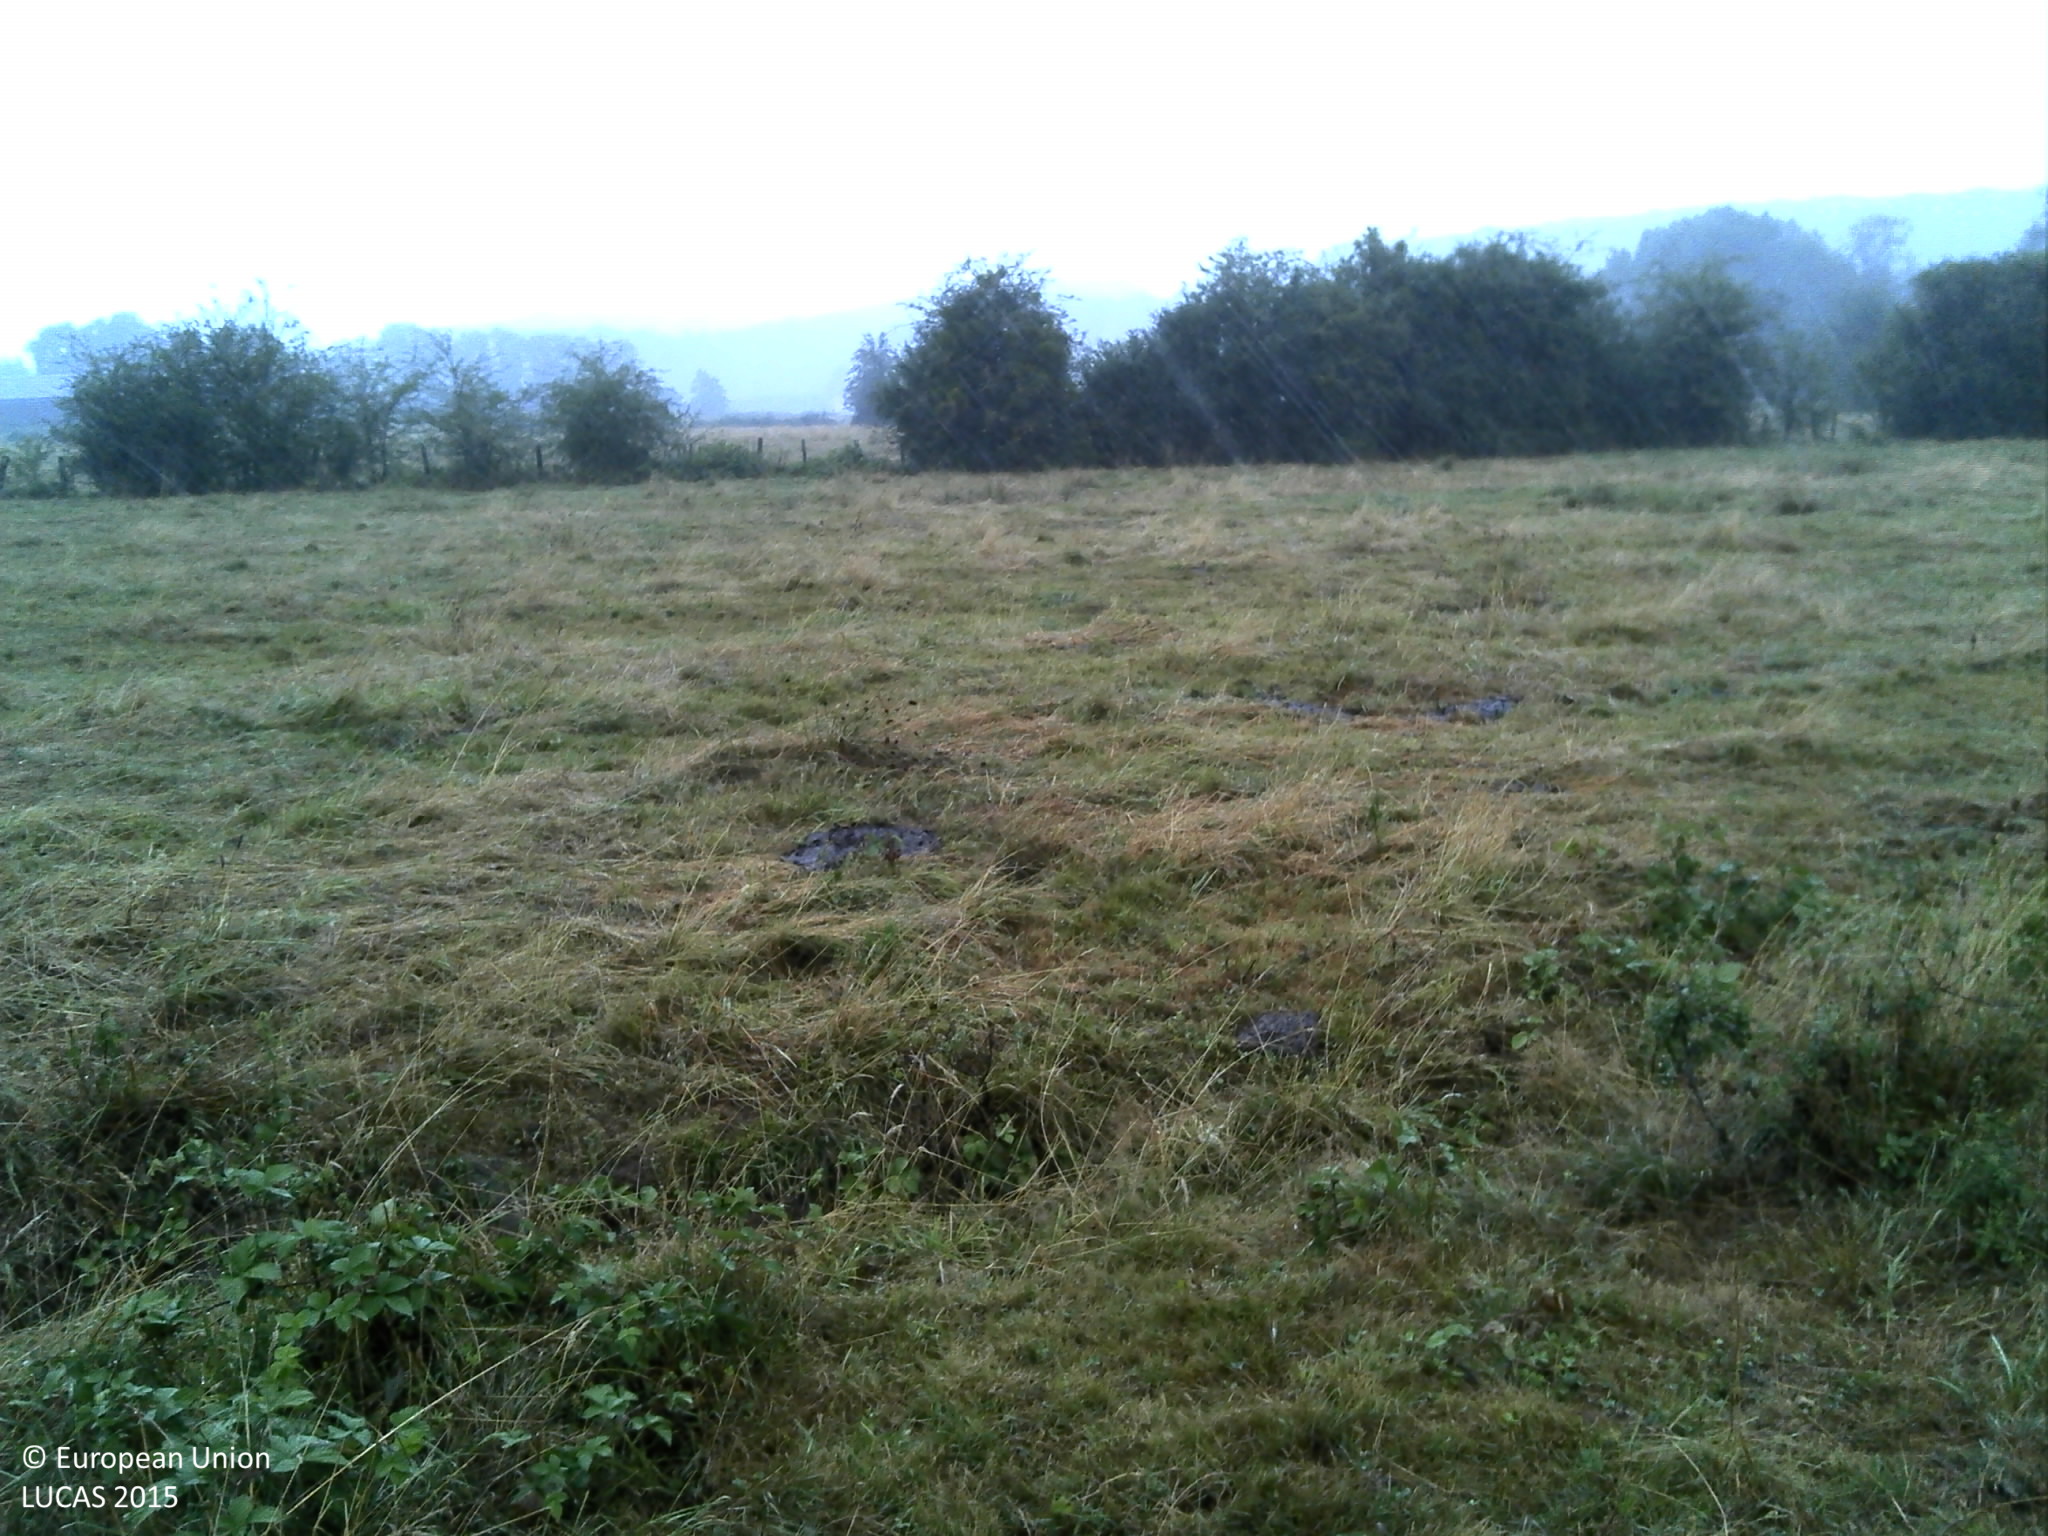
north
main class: Grassland
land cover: Grassland without tree/shrub cover
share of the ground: > 75 %
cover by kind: herbaceous plants 100 %
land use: Agriculture (excluding fallow land and kitchen gardens)
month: July
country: FR
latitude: 47.9621
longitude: 6.2643
